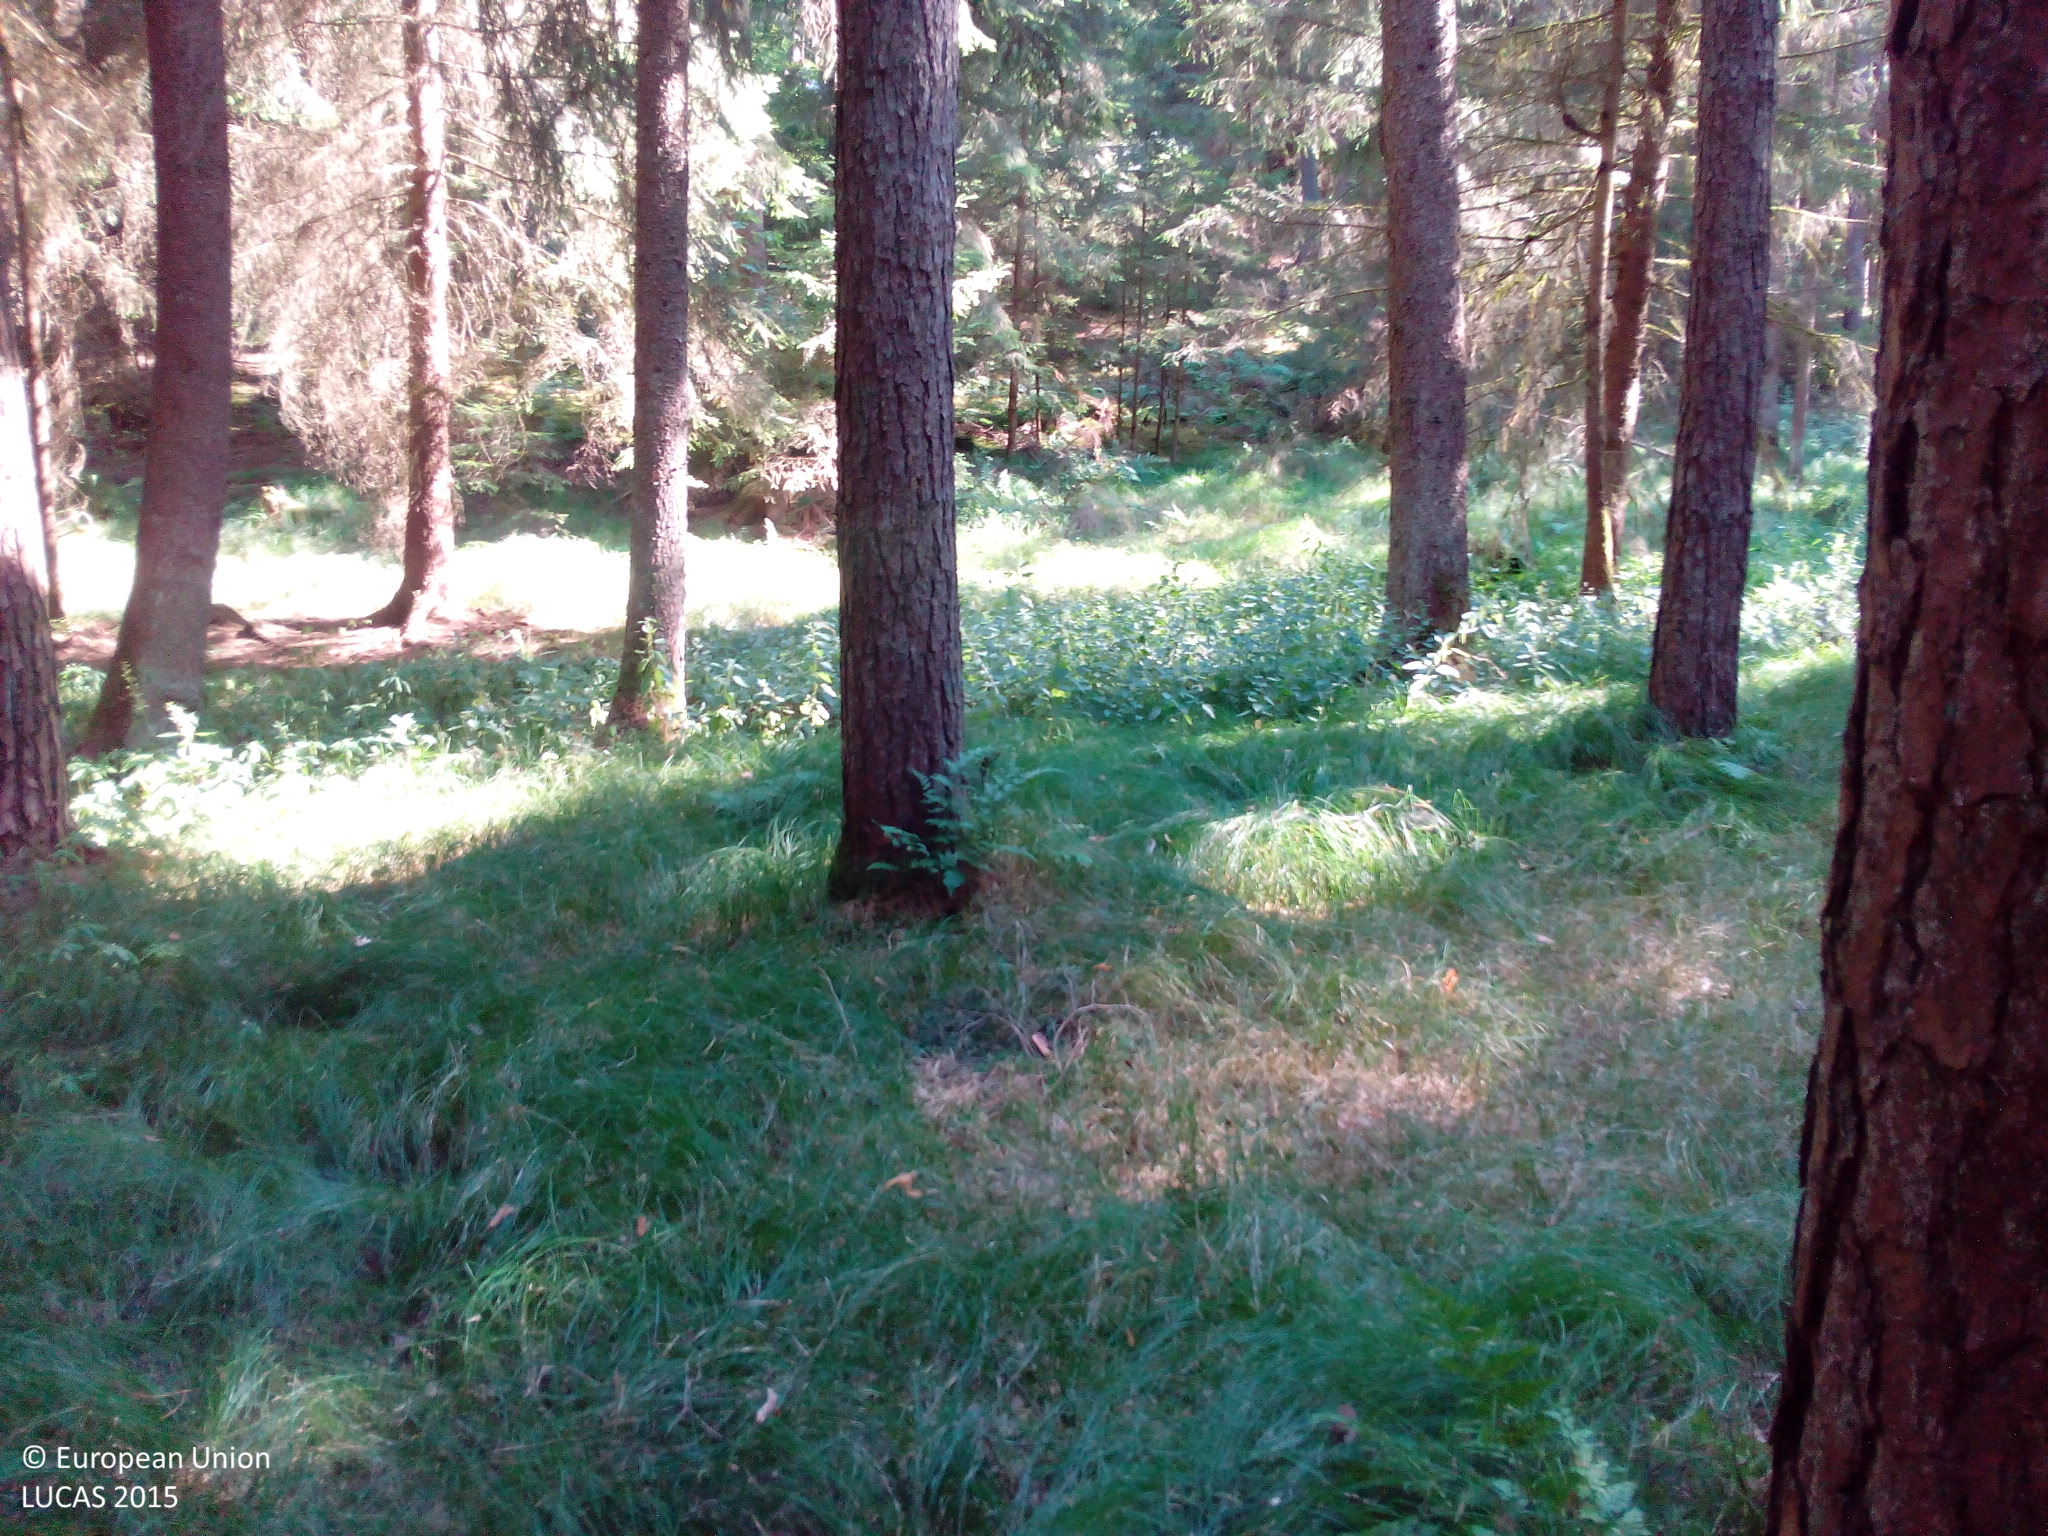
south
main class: Woodland
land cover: Other coniferous woodland
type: hemiboreal forest and nemoral coniferous forest and mixed broadleaved-coniferous forest
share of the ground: > 75 %
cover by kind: coniferous forest trees 85 %, herbaceous plants 10 %, unconsolidated bare surface 5 %
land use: Forestry
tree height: > 5 m
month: July
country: DE
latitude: 49.3534
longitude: 10.8945
